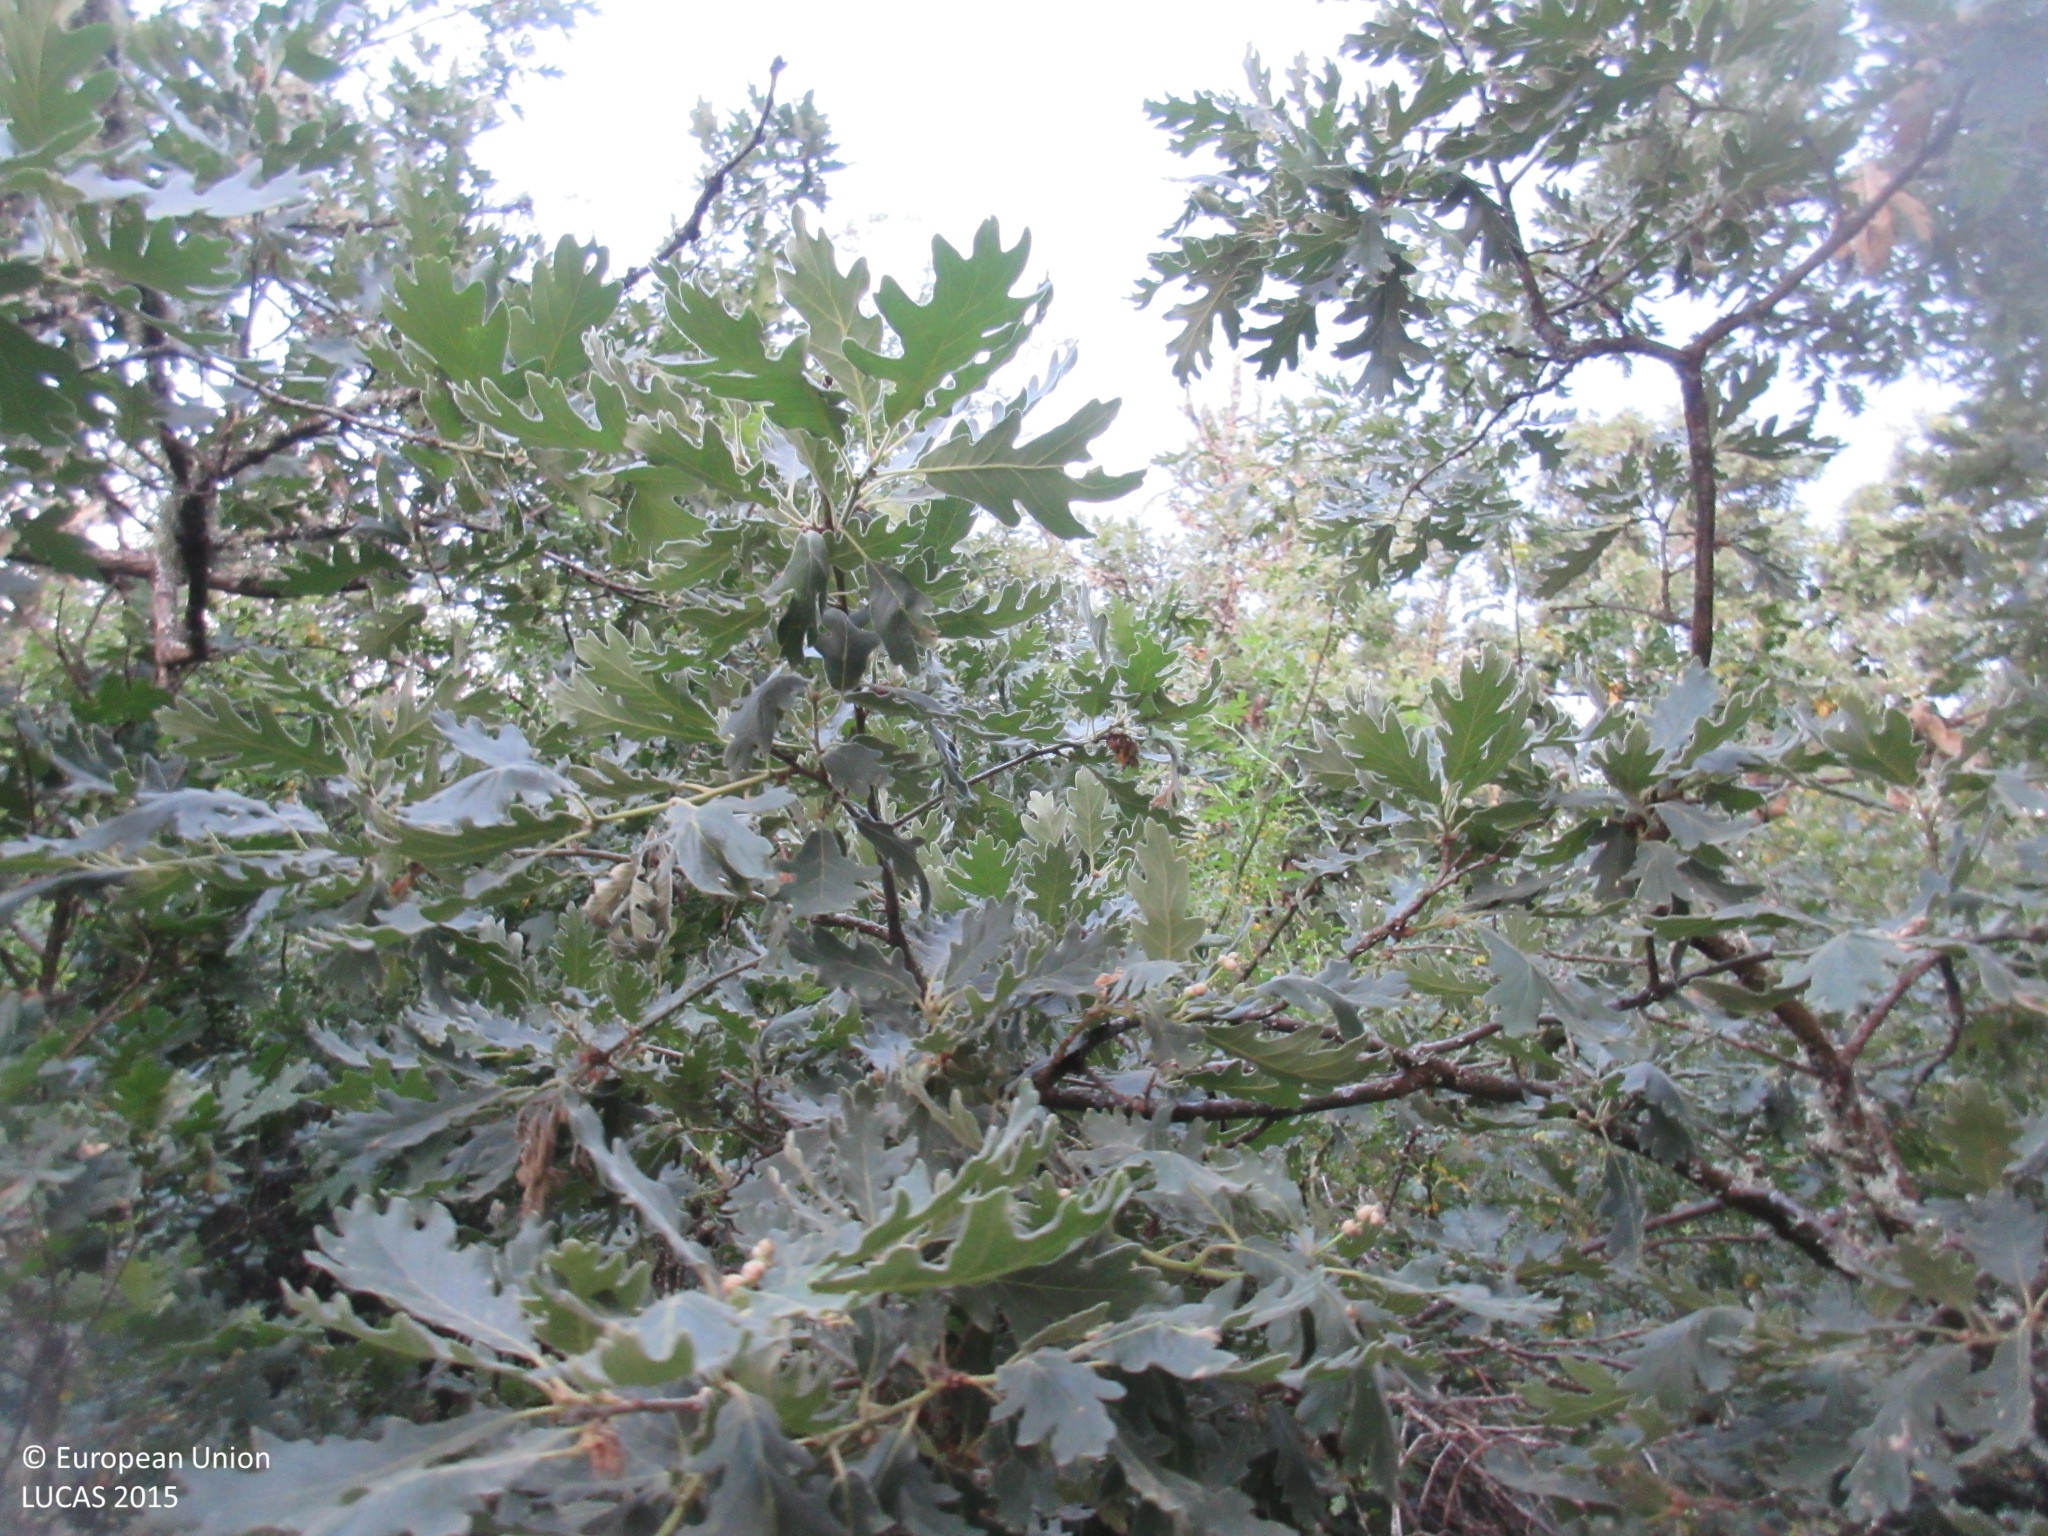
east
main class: Woodland
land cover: Broadleaved woodland
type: acidophilous oak and oak-birch forest
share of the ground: > 75 %
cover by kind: broadleaved forest trees 90 %, shrubs 10 %
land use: Semi-natural and natural areas not in use
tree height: > 5 m
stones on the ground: 10 - 25 %
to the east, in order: Broadleaved woodland
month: July
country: ES
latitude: 42.8769
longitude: -4.4388
